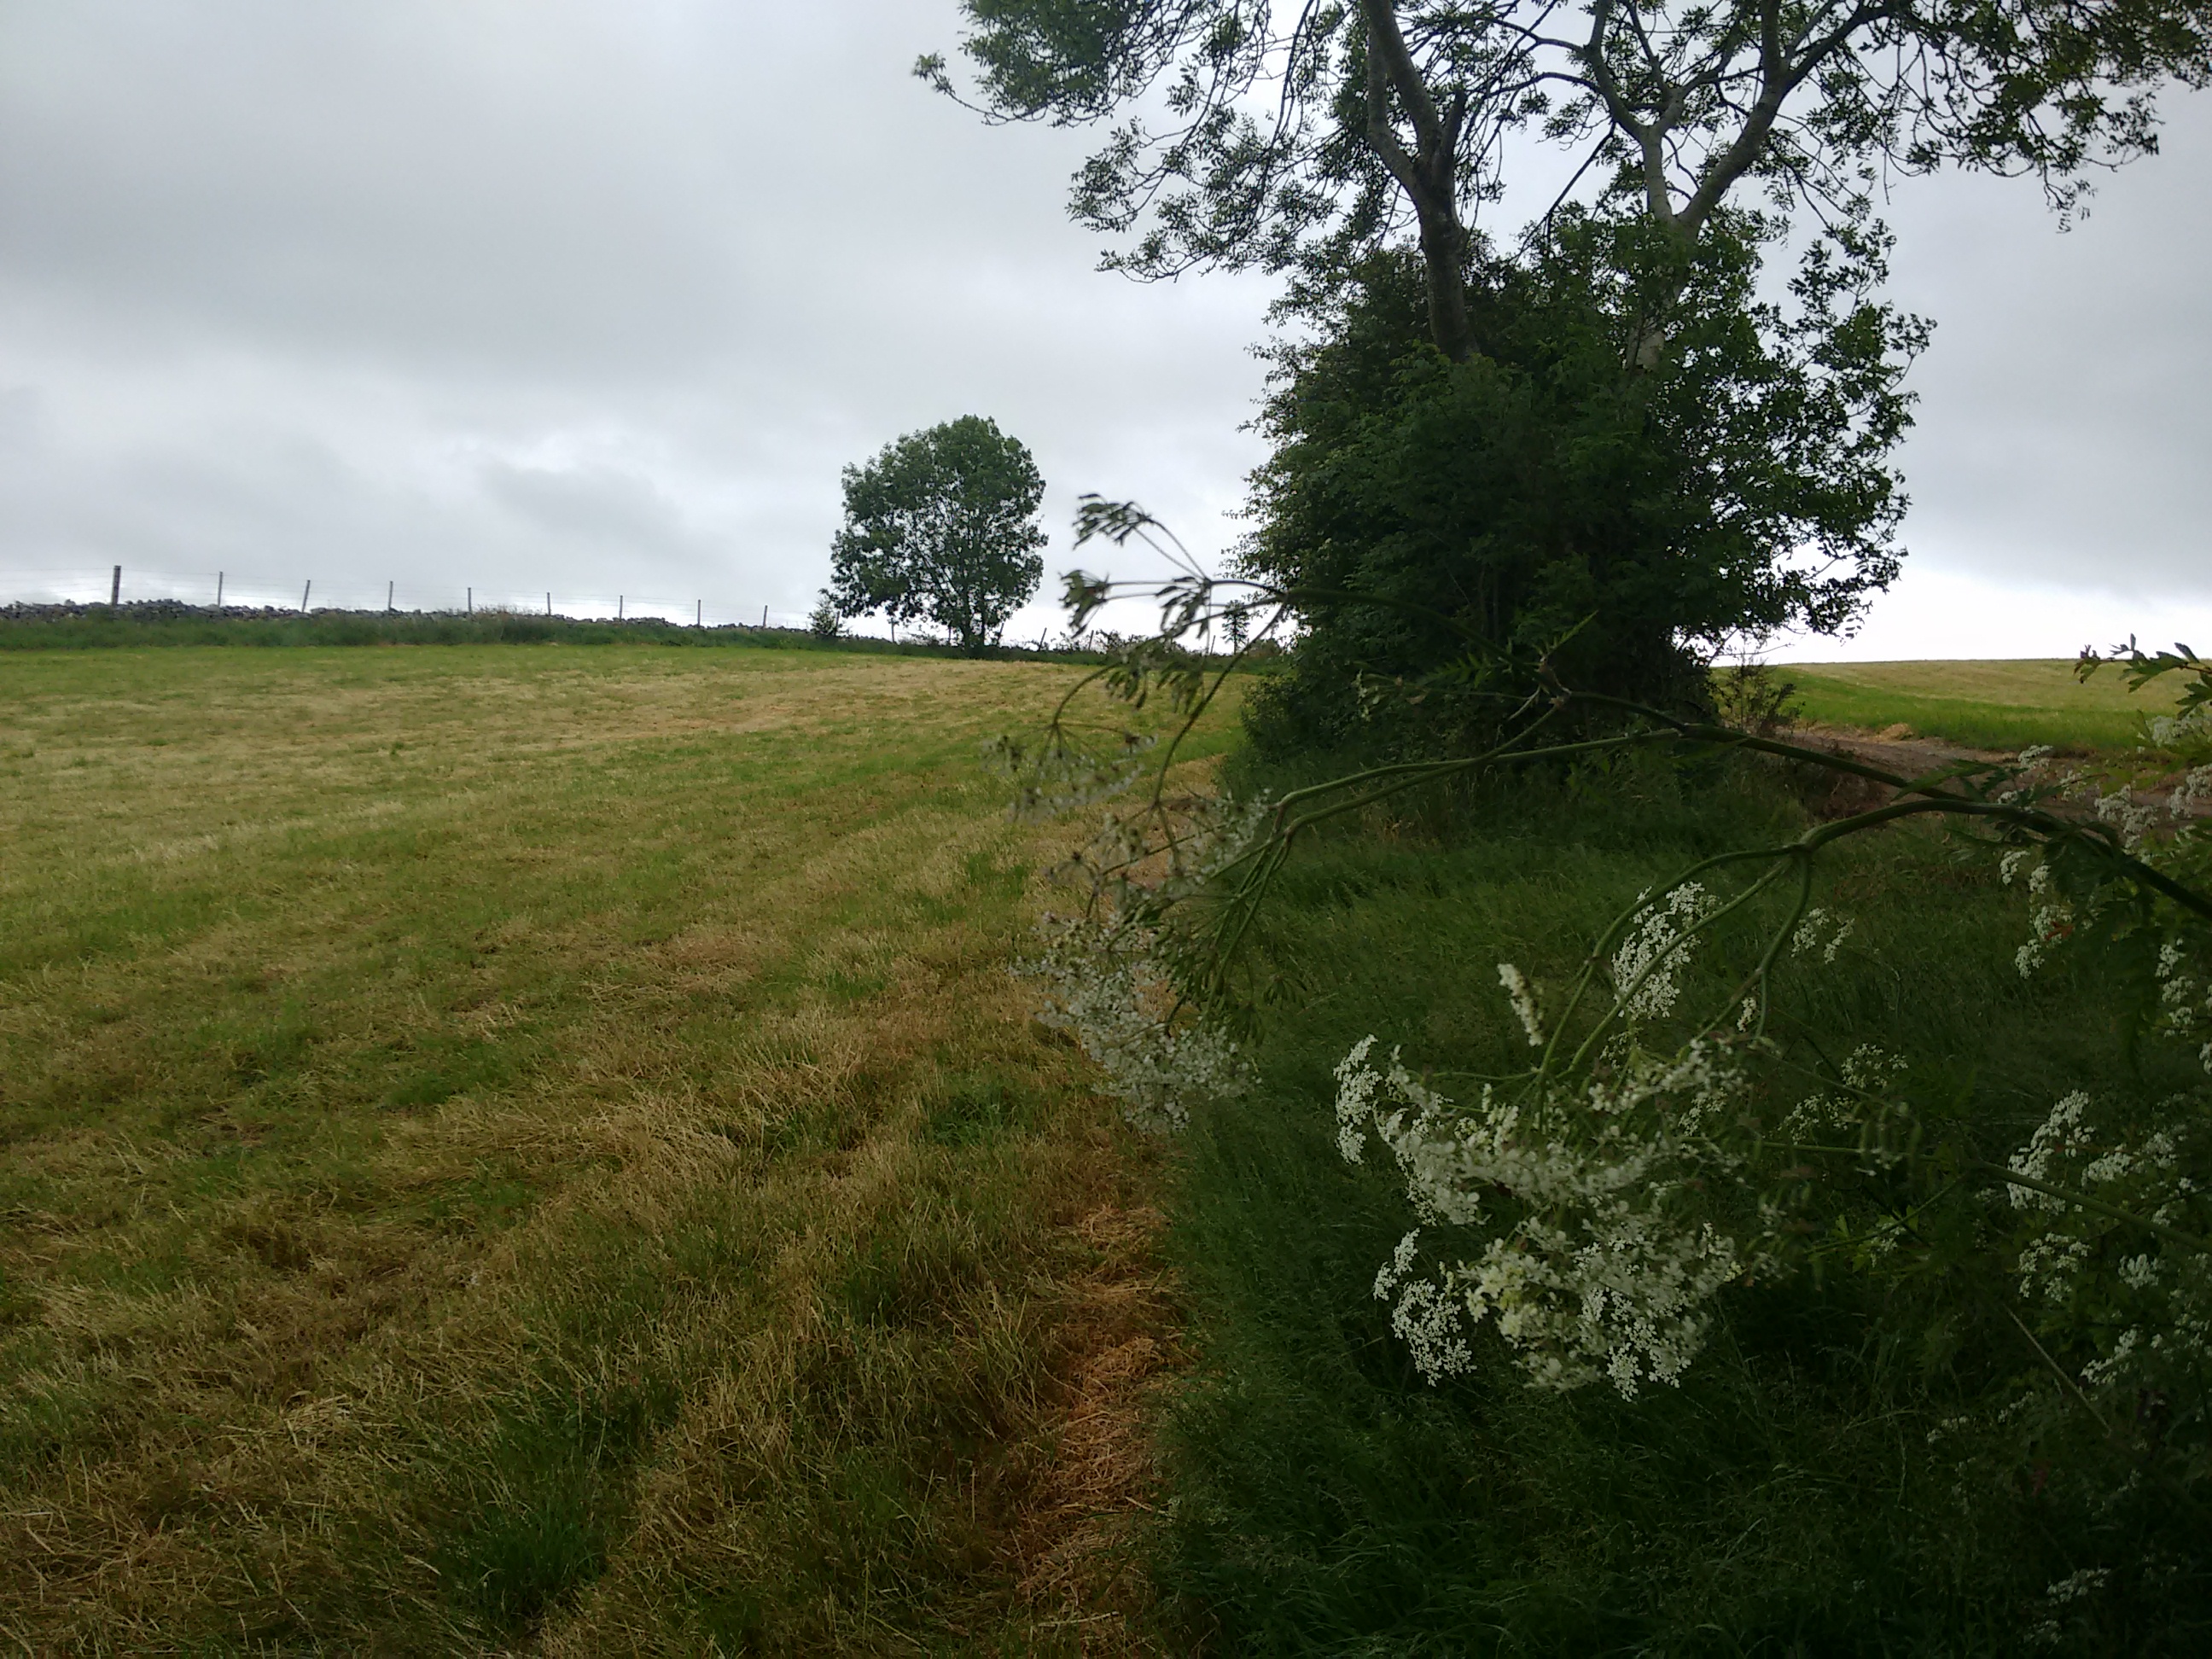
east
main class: Grassland
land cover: Grassland without tree/shrub cover
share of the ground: > 75 %
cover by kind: herbaceous plants 100 %
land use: Agriculture (excluding fallow land and kitchen gardens)
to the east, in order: Abandoned hedges; Grassland without tree/shrub cover; Grass margins; Dry stone walls; Fences; Grass margins; Grassland without tree/shrub cover; Fences; Managed hedges; Grass margins; Paved roads, cycling and walking lanes; Grass margins; Fences; Grassland without tree/shrub cover
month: June
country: GB
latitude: 54.6913
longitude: -7.5159
